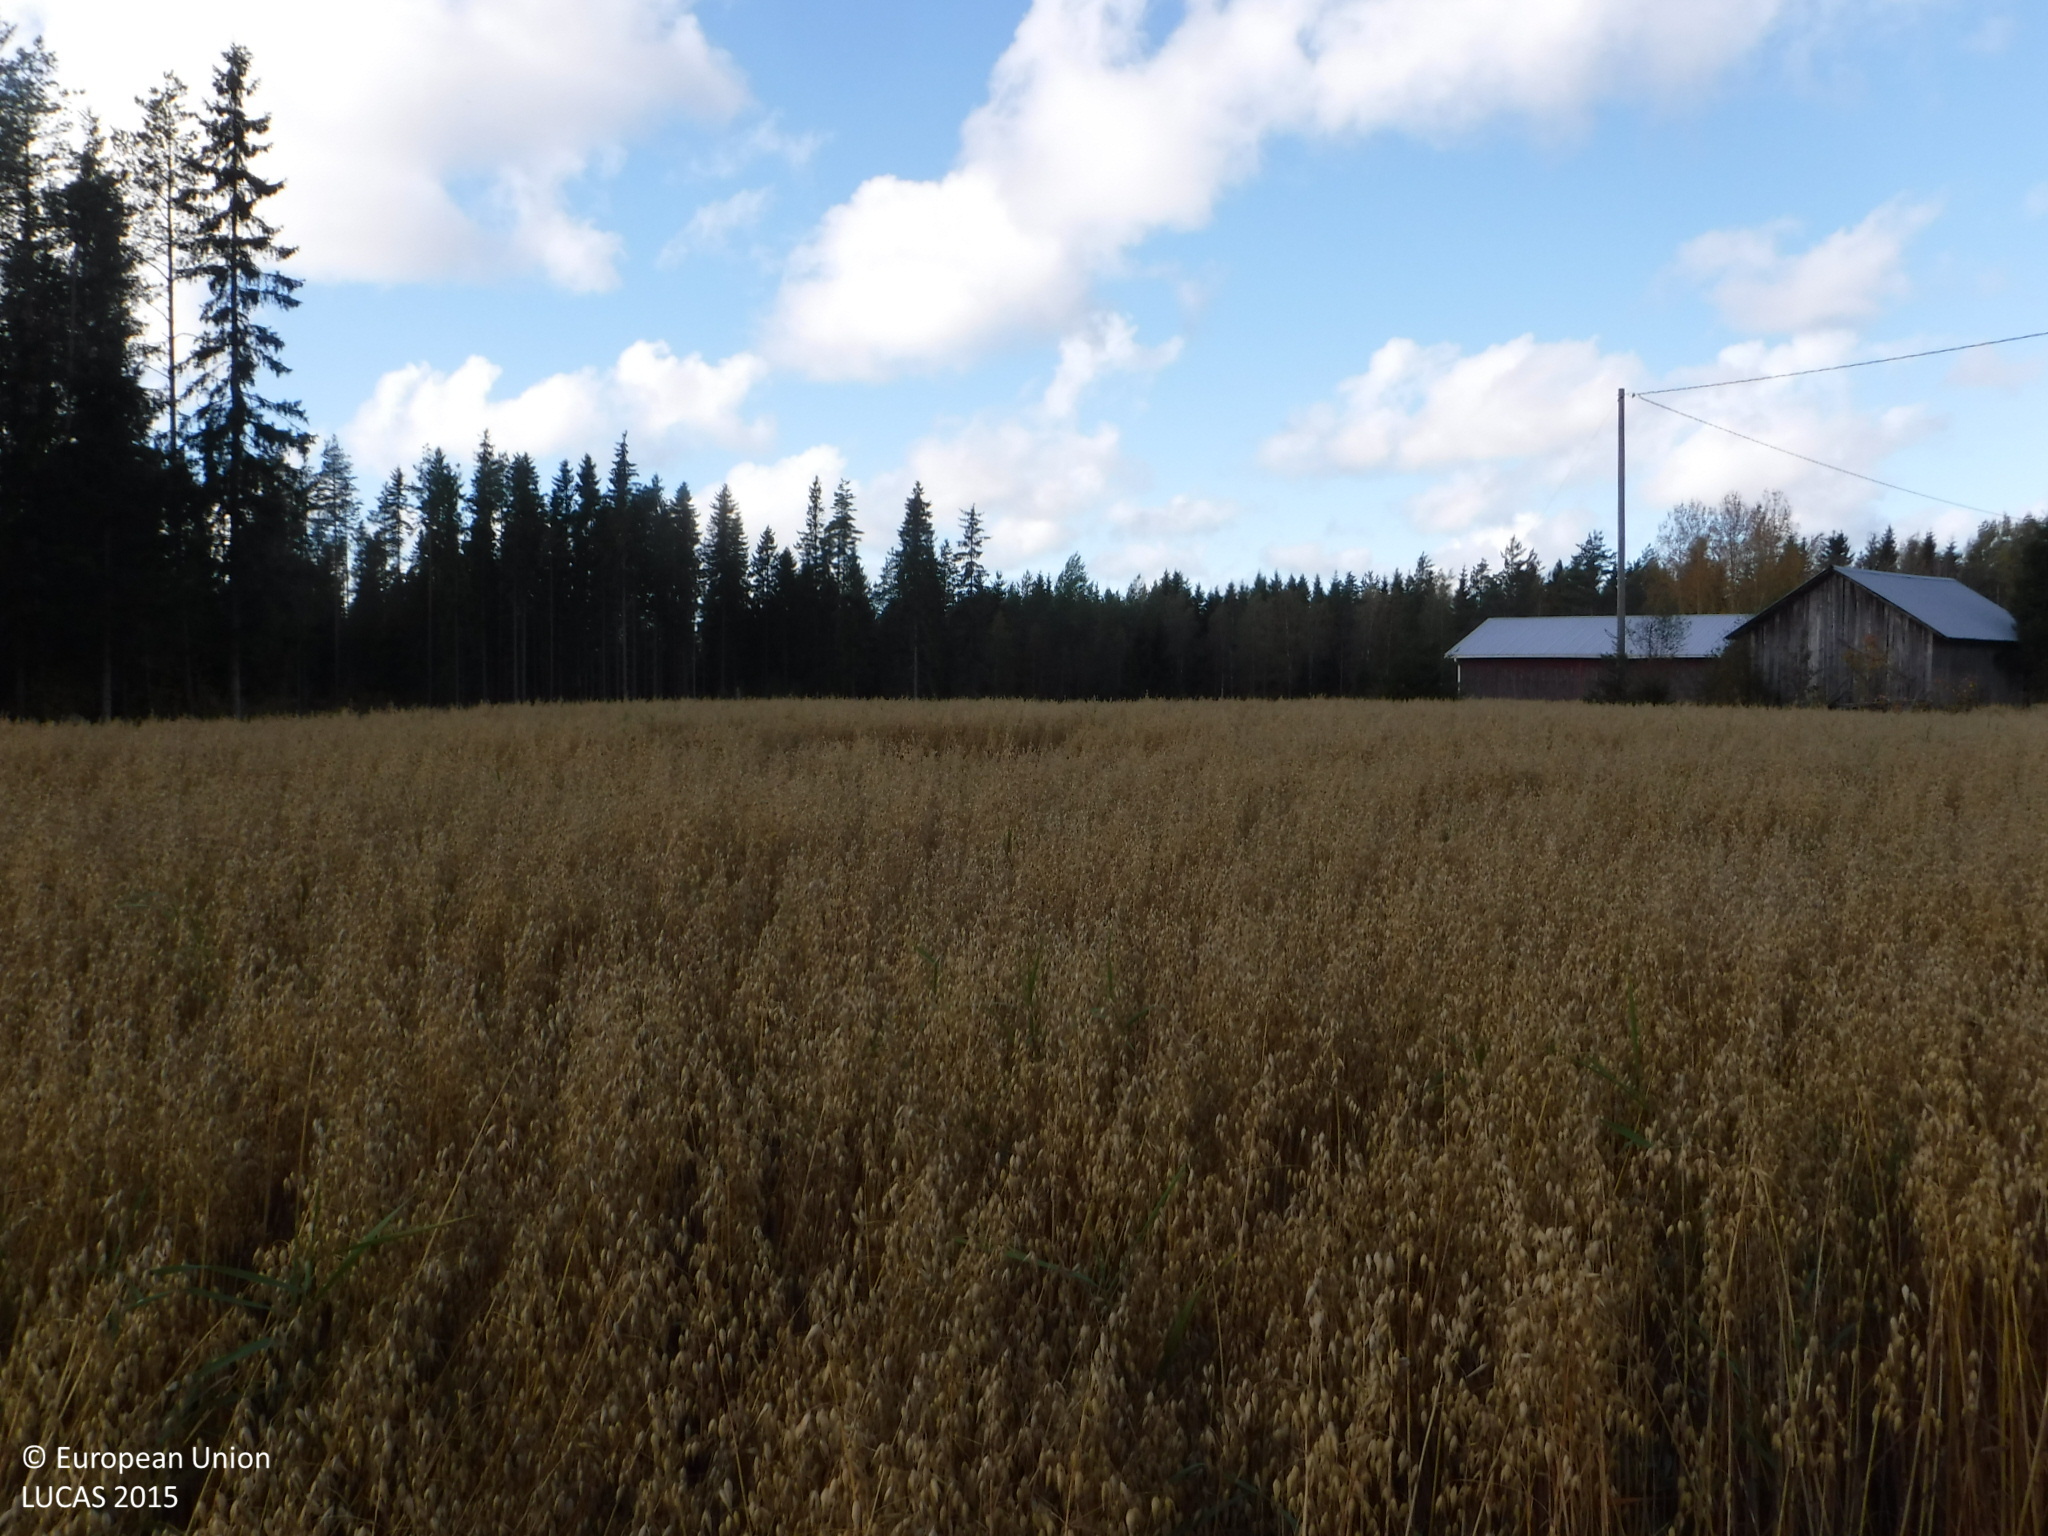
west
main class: Cropland
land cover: Oats
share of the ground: > 75 %
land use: Agriculture (excluding fallow land and kitchen gardens)
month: September
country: FI
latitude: 62.0987
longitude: 21.7146
